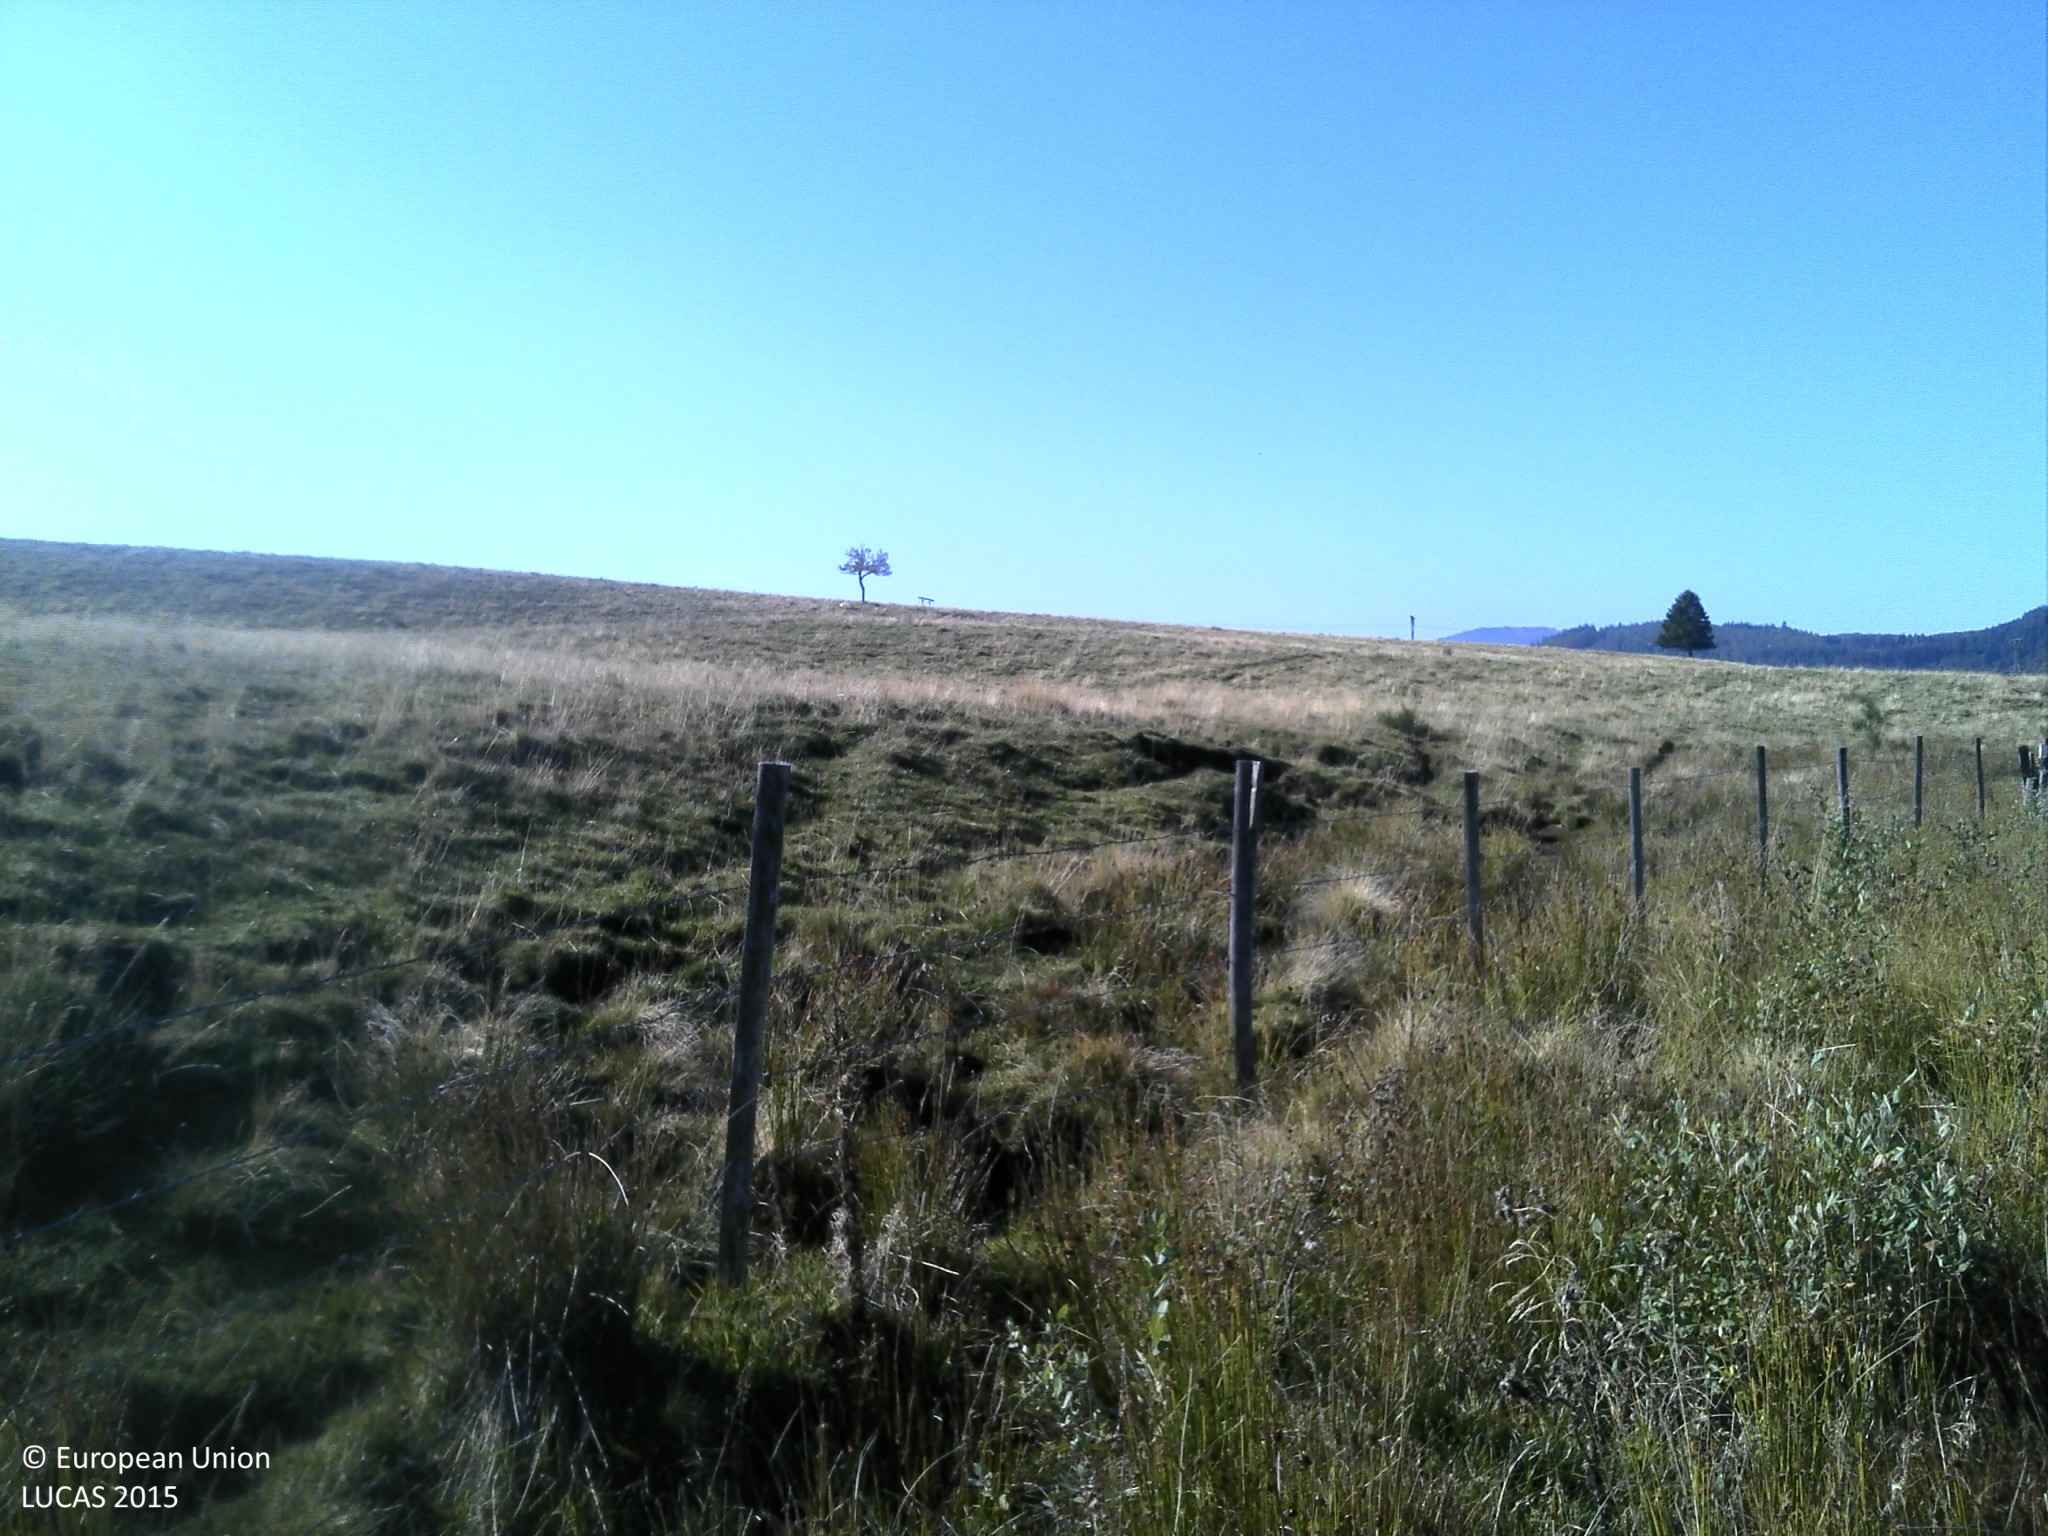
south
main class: Grassland
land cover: Grassland without tree/shrub cover
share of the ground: > 75 %
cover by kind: herbaceous plants 100 %
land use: Semi-natural and natural areas not in use
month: October
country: FR
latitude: 45.4660
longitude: 2.9274
